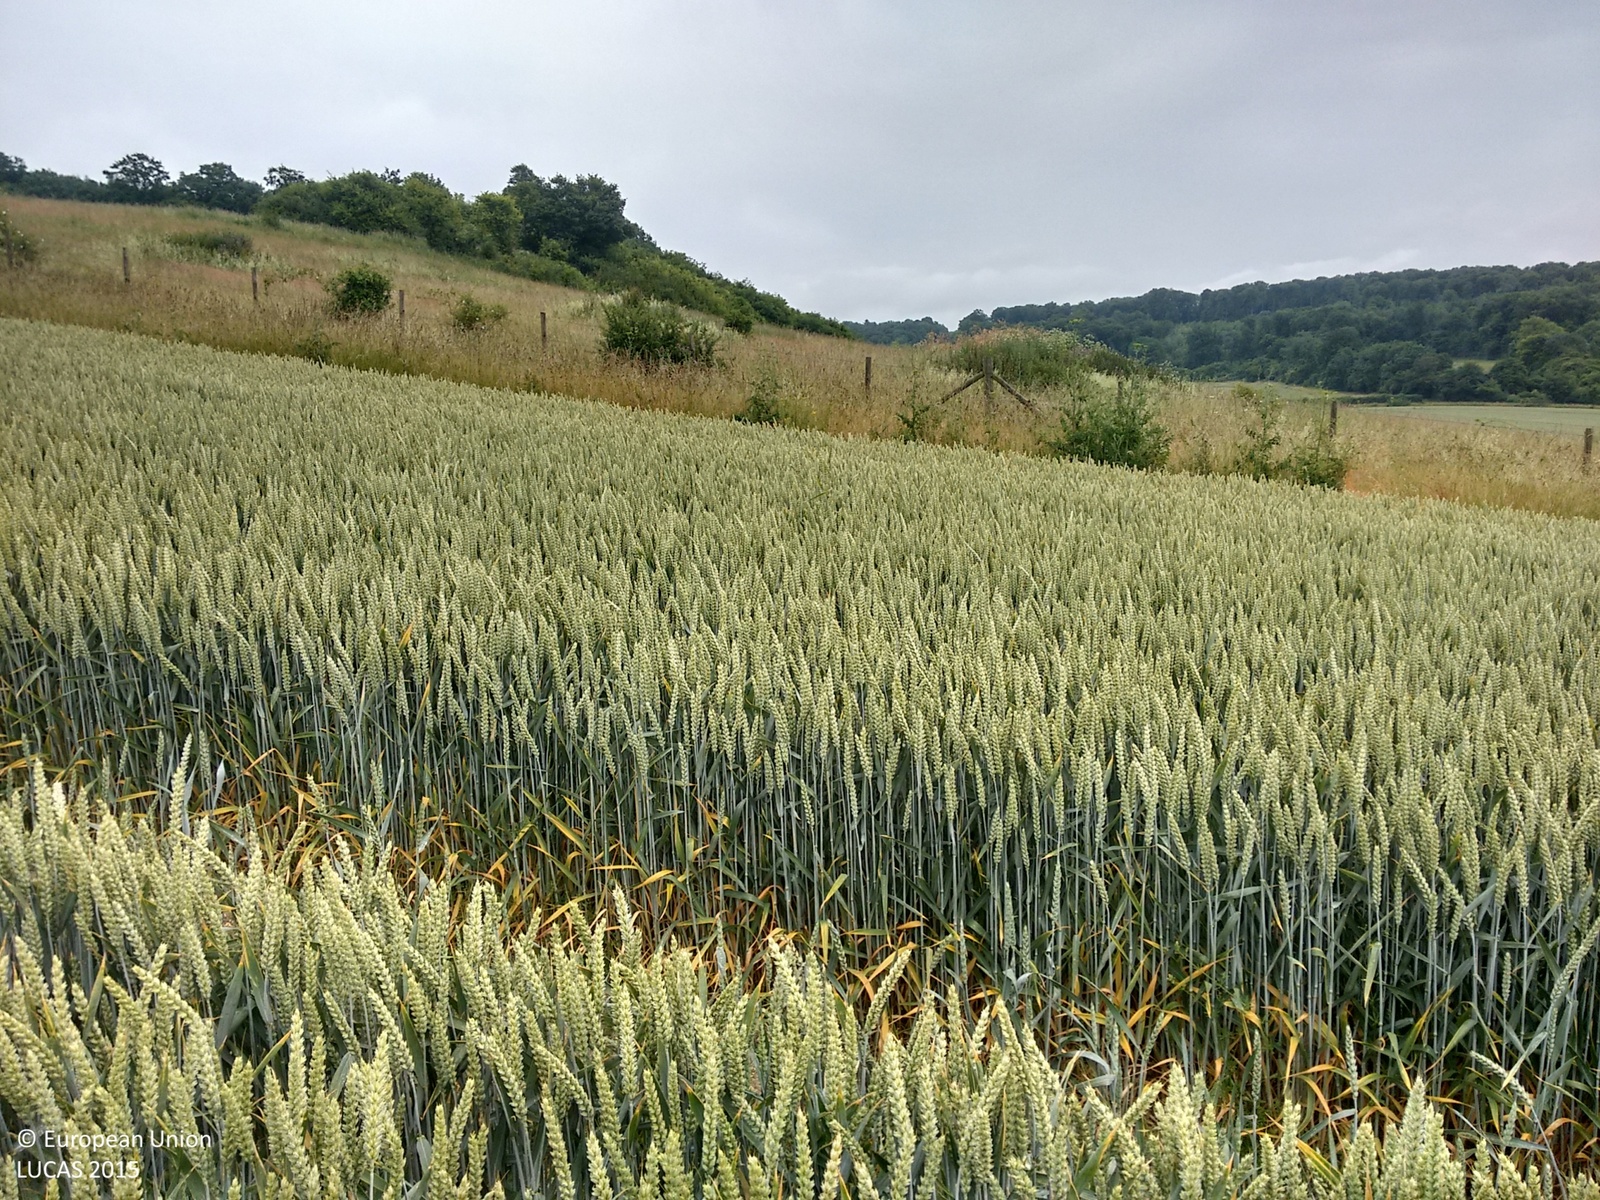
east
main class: Cropland
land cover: Common wheat
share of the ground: > 75 %
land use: Agriculture (excluding fallow land and kitchen gardens)
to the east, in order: Common wheat; Grassland without tree/shrub cover; Fences; Grassland without tree/shrub cover; Tracks; Grassland without tree/shrub cover; Shrubland without tree cover; Grassland without tree/shrub cover
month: July
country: GB
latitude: 51.5487
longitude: -1.0775
